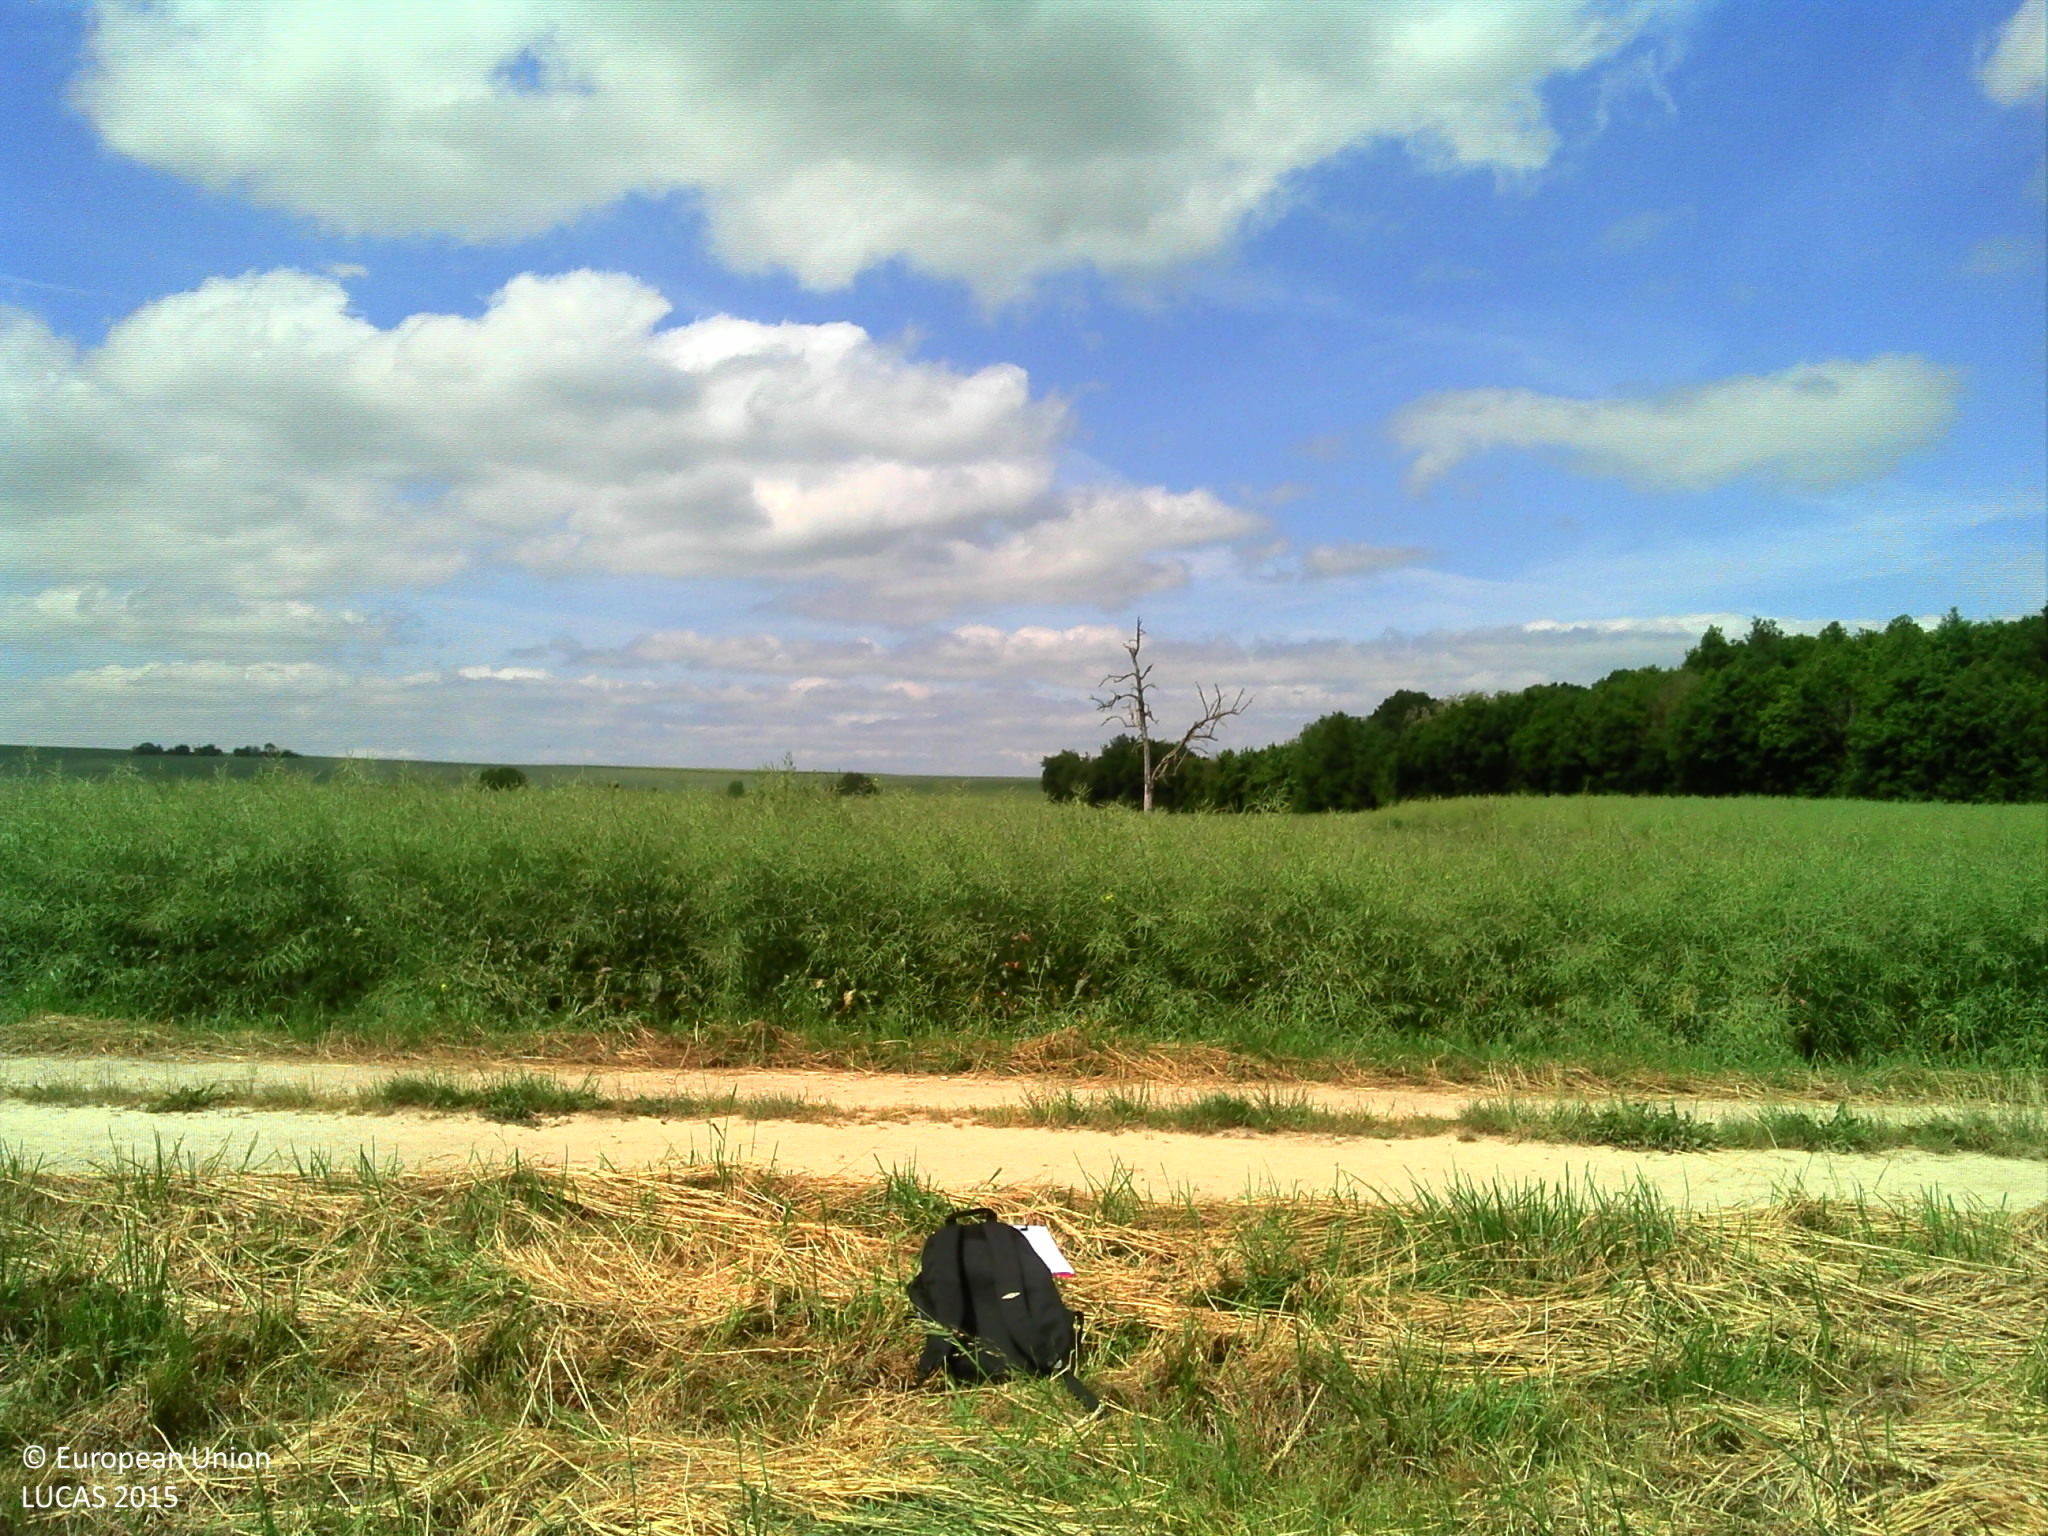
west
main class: Cropland
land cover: Common wheat
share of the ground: > 75 %
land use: Agriculture (excluding fallow land and kitchen gardens)
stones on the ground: < 10 %
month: May
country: FR
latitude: 47.4201
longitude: 5.2951
